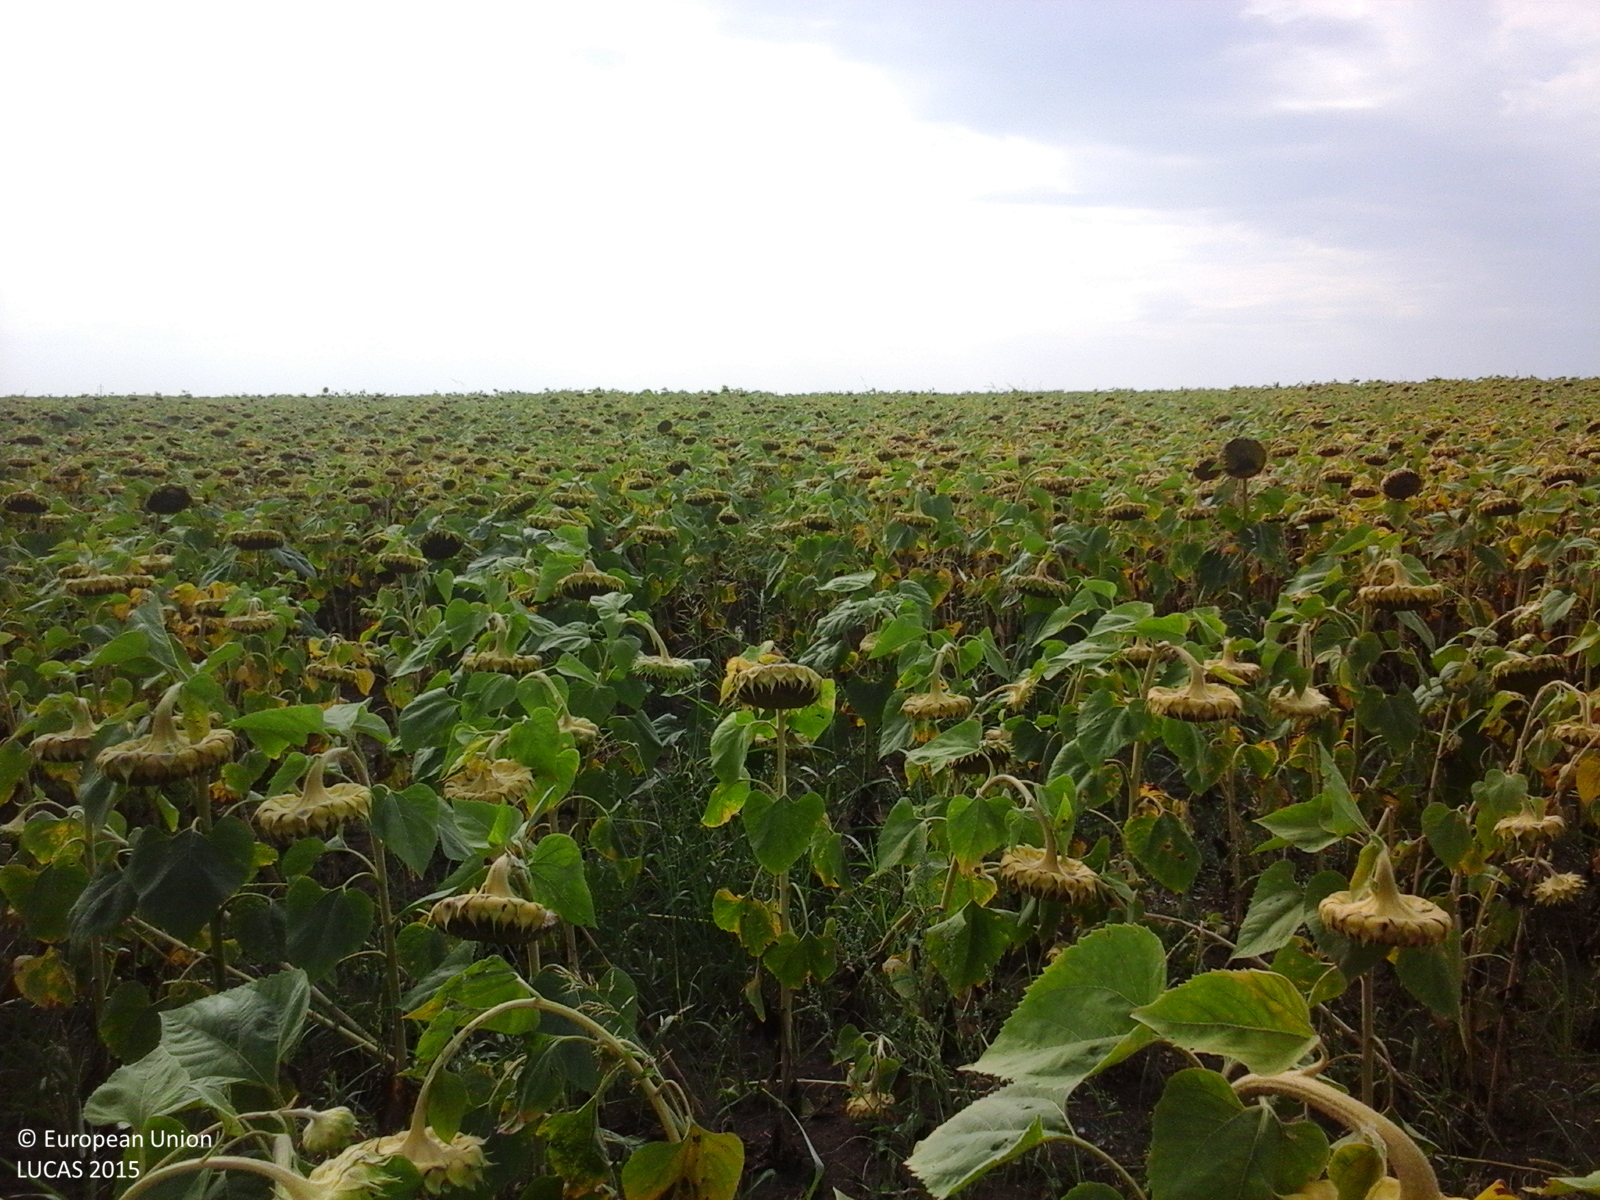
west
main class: Cropland
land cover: Sunflower
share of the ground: > 75 %
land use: Agriculture (excluding fallow land and kitchen gardens)
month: August
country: RO
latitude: 44.1932
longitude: 28.3442
